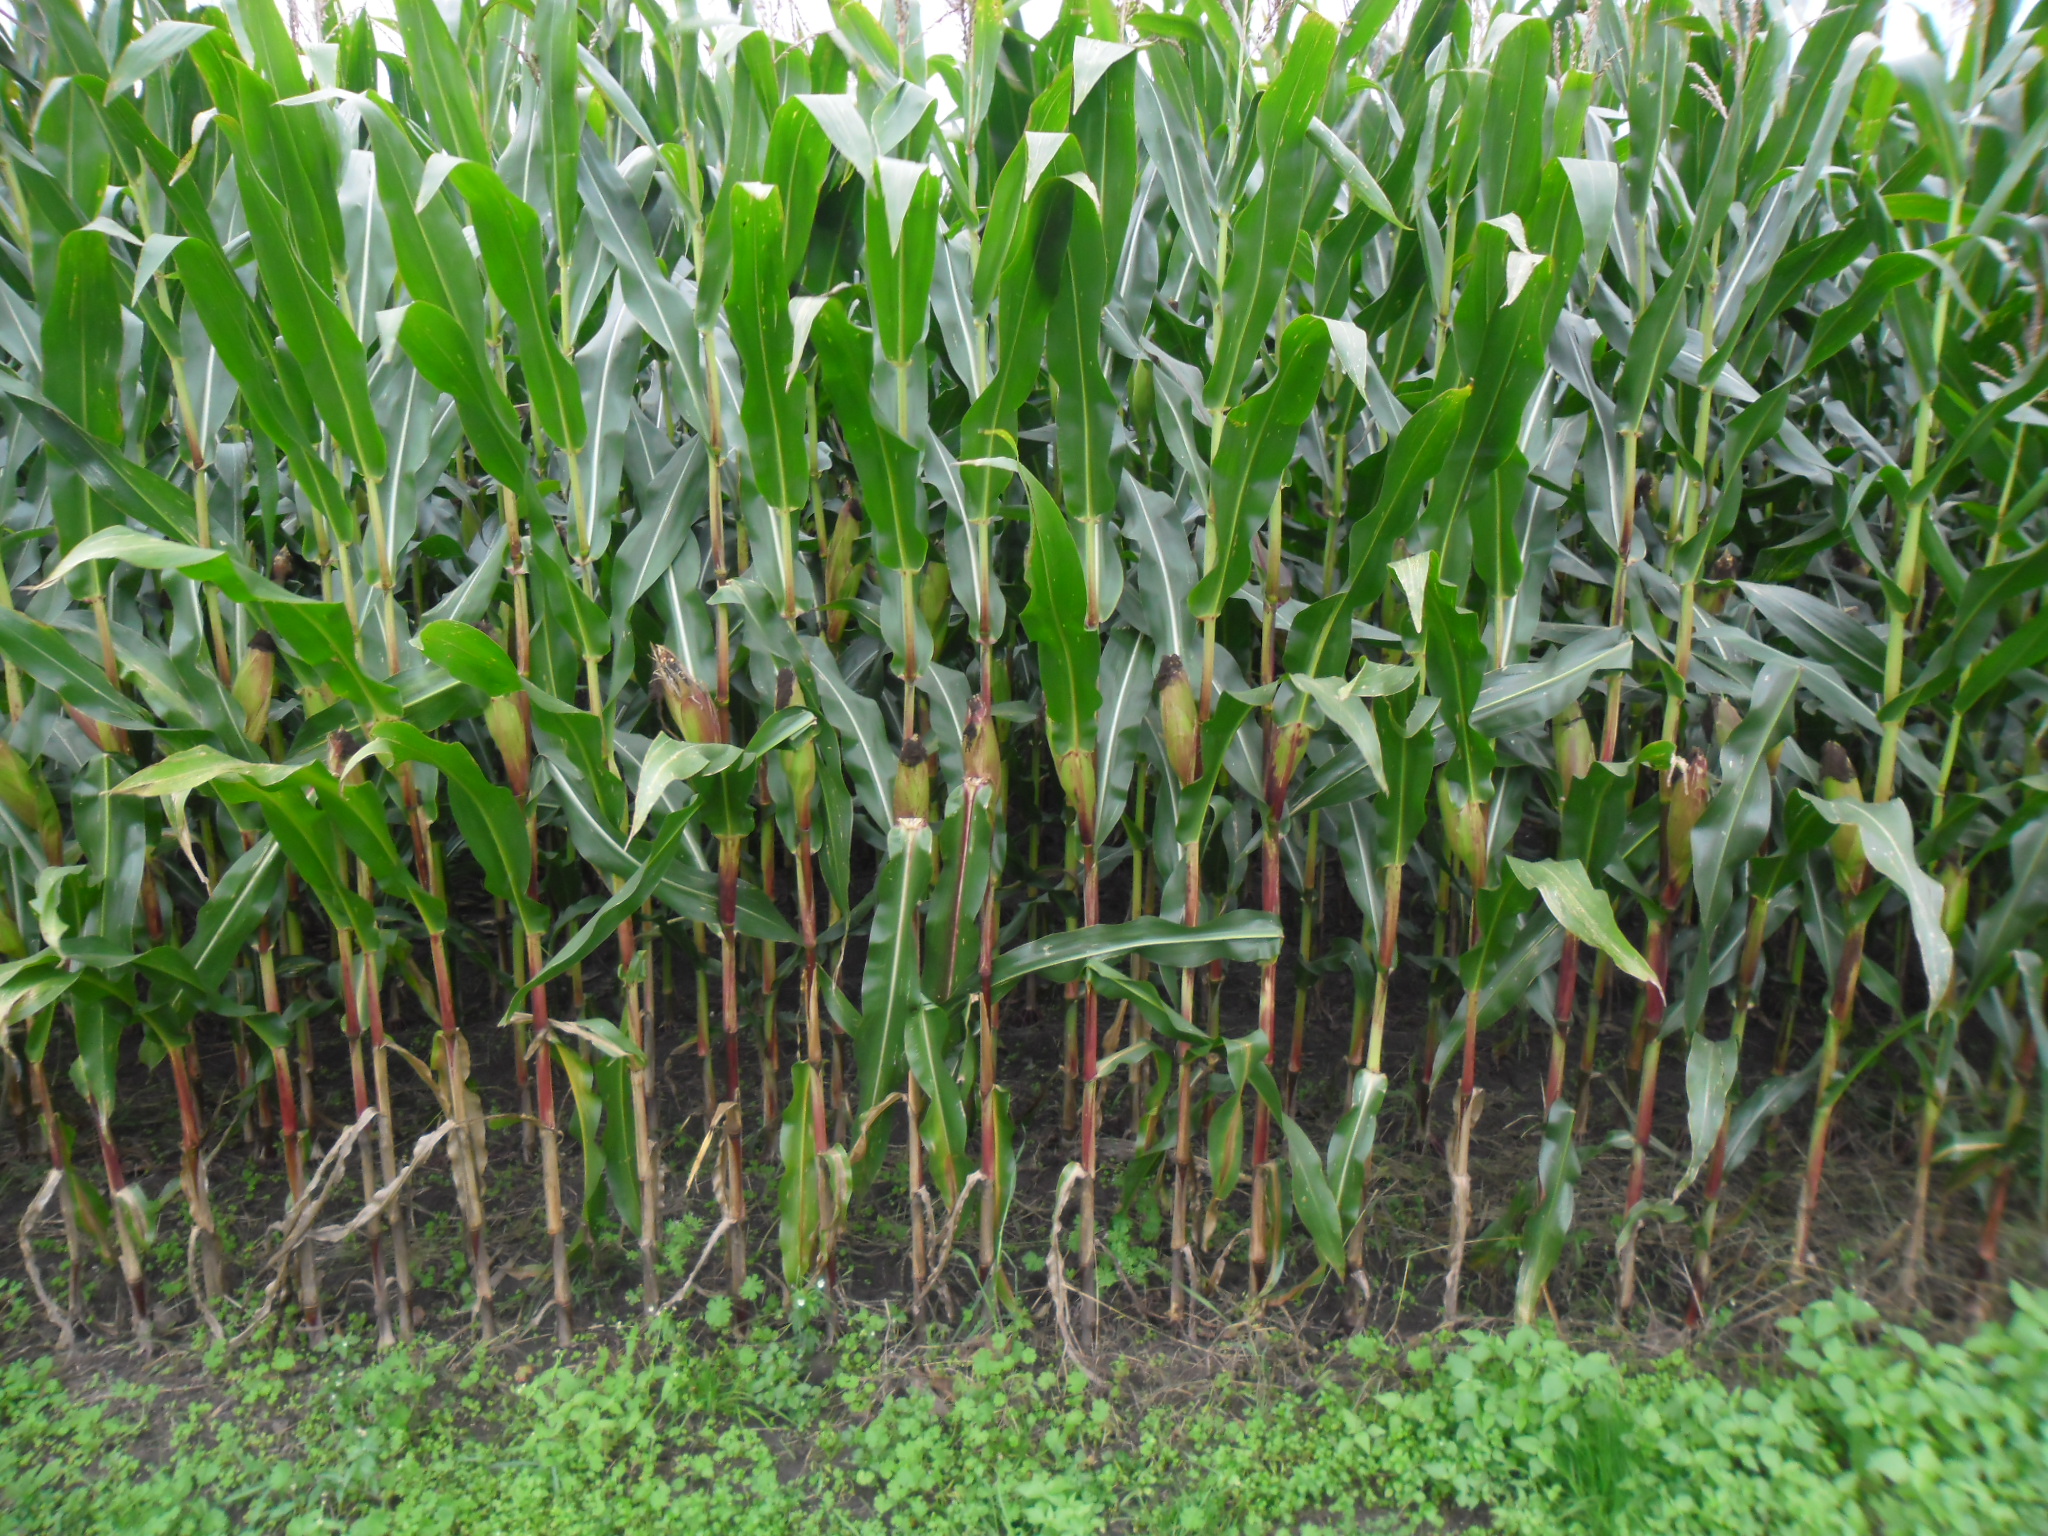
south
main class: Grassland
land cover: Grassland without tree/shrub cover
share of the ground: > 75 %
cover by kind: herbaceous plants 100 %
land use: Residential
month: September
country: NL
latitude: 52.1193
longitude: 5.6902
